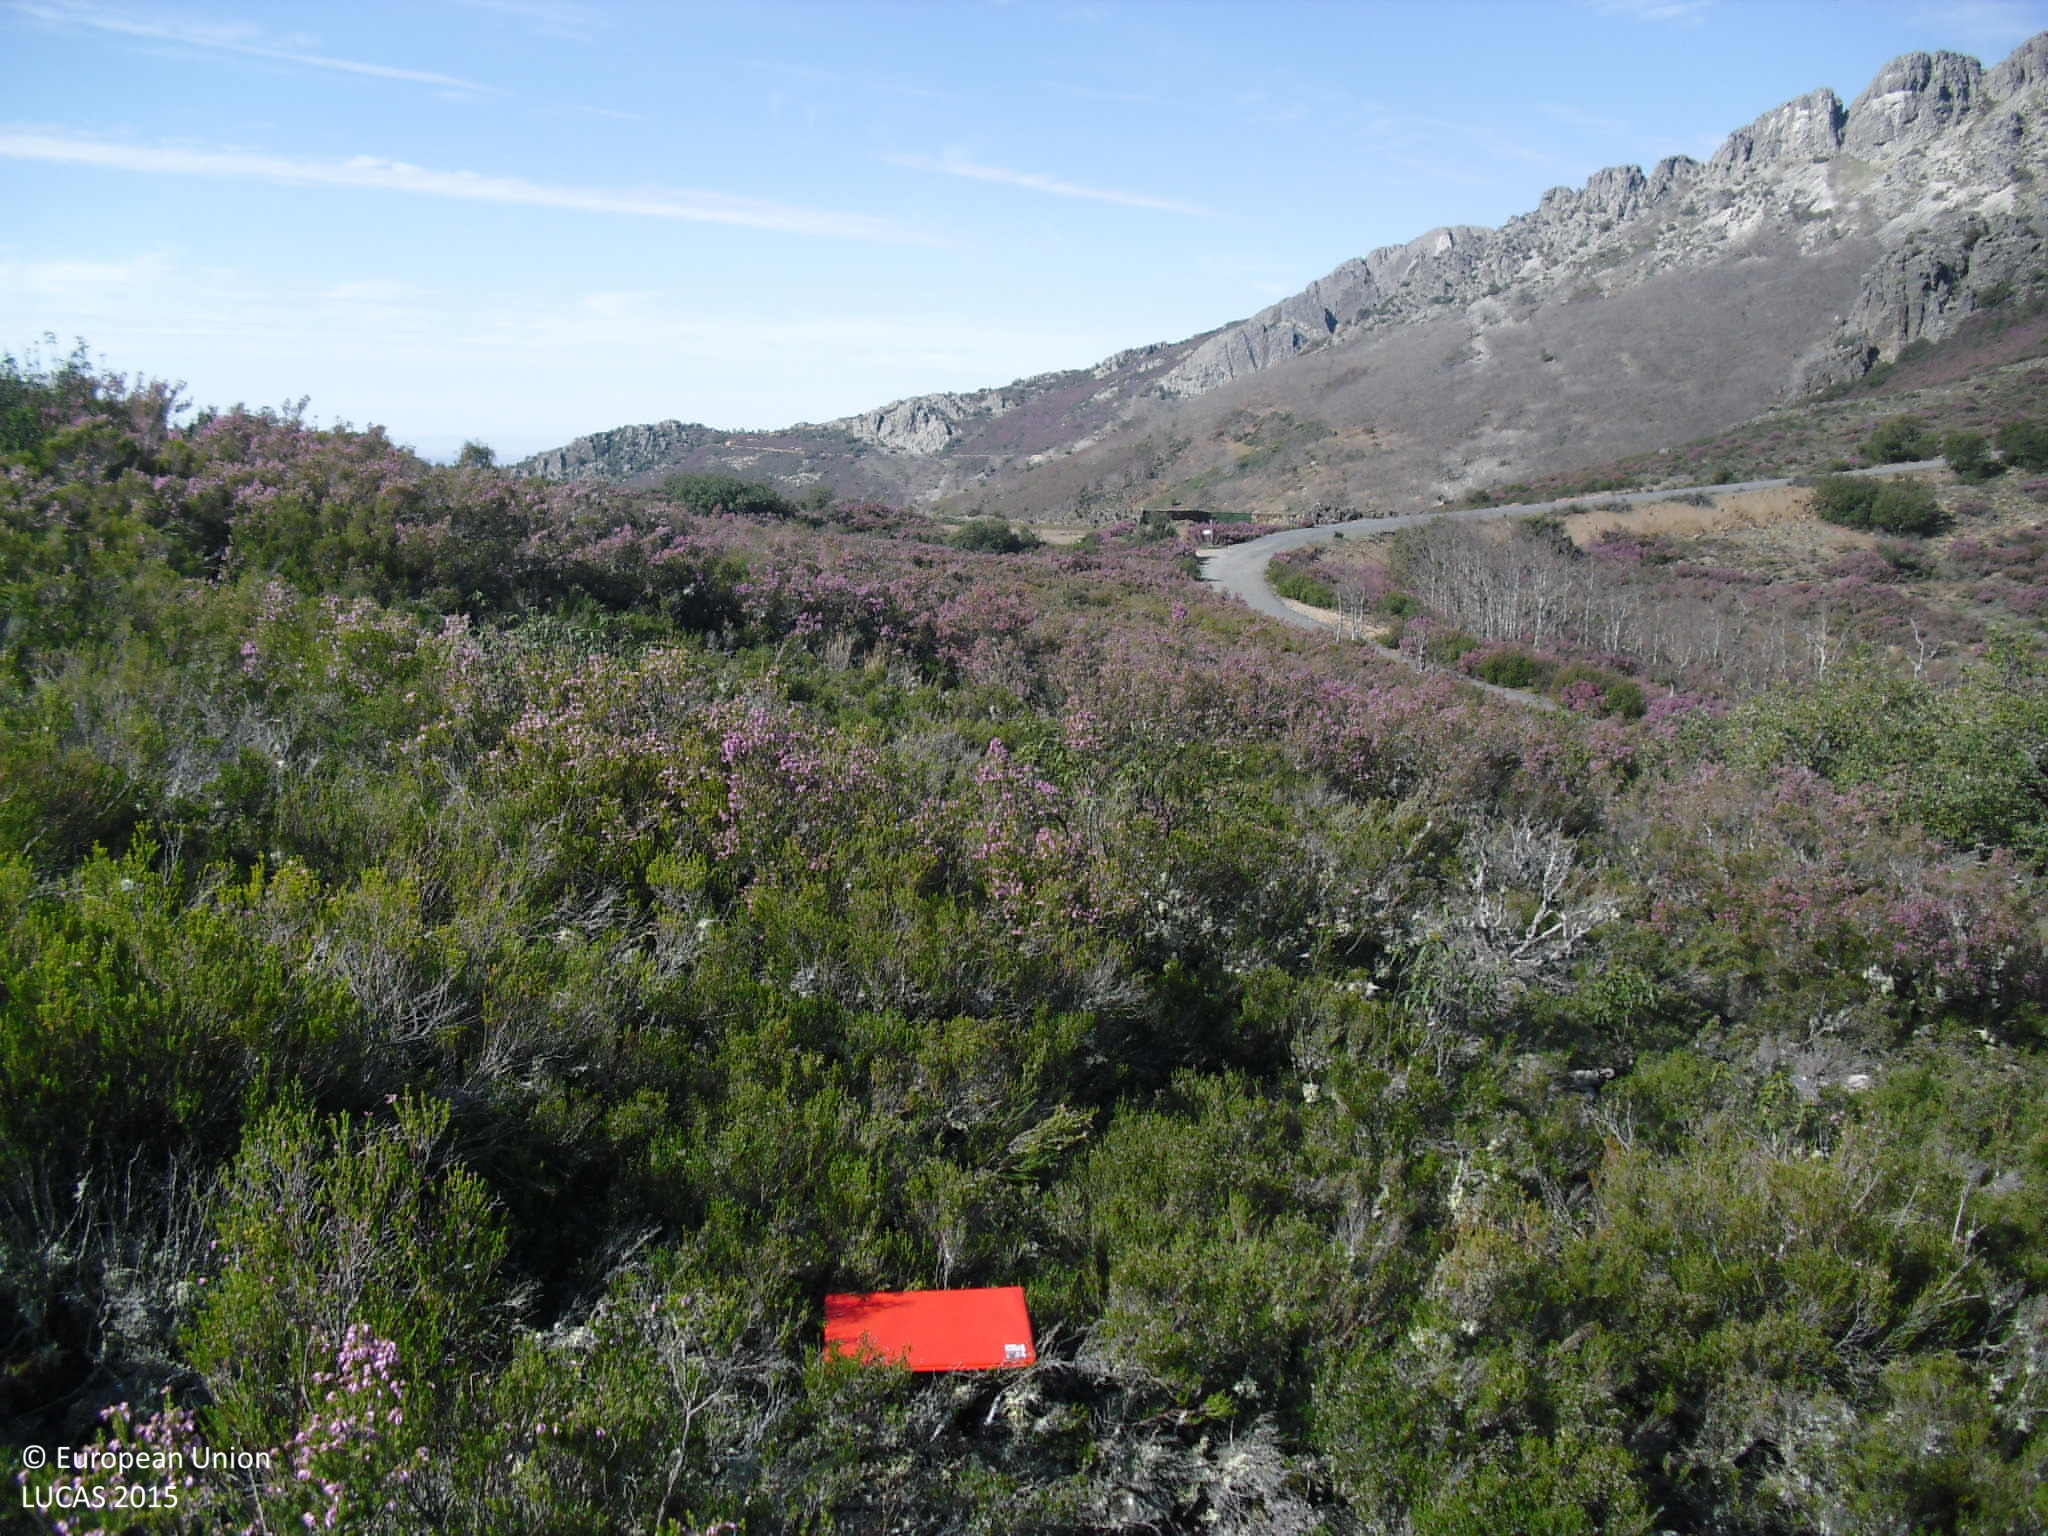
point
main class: Shrubland
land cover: Shrubland without tree cover
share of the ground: > 75 %
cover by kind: shrubs 100 %
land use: Semi-natural and natural areas not in use
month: April
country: ES
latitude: 39.4691
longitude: -5.3812
